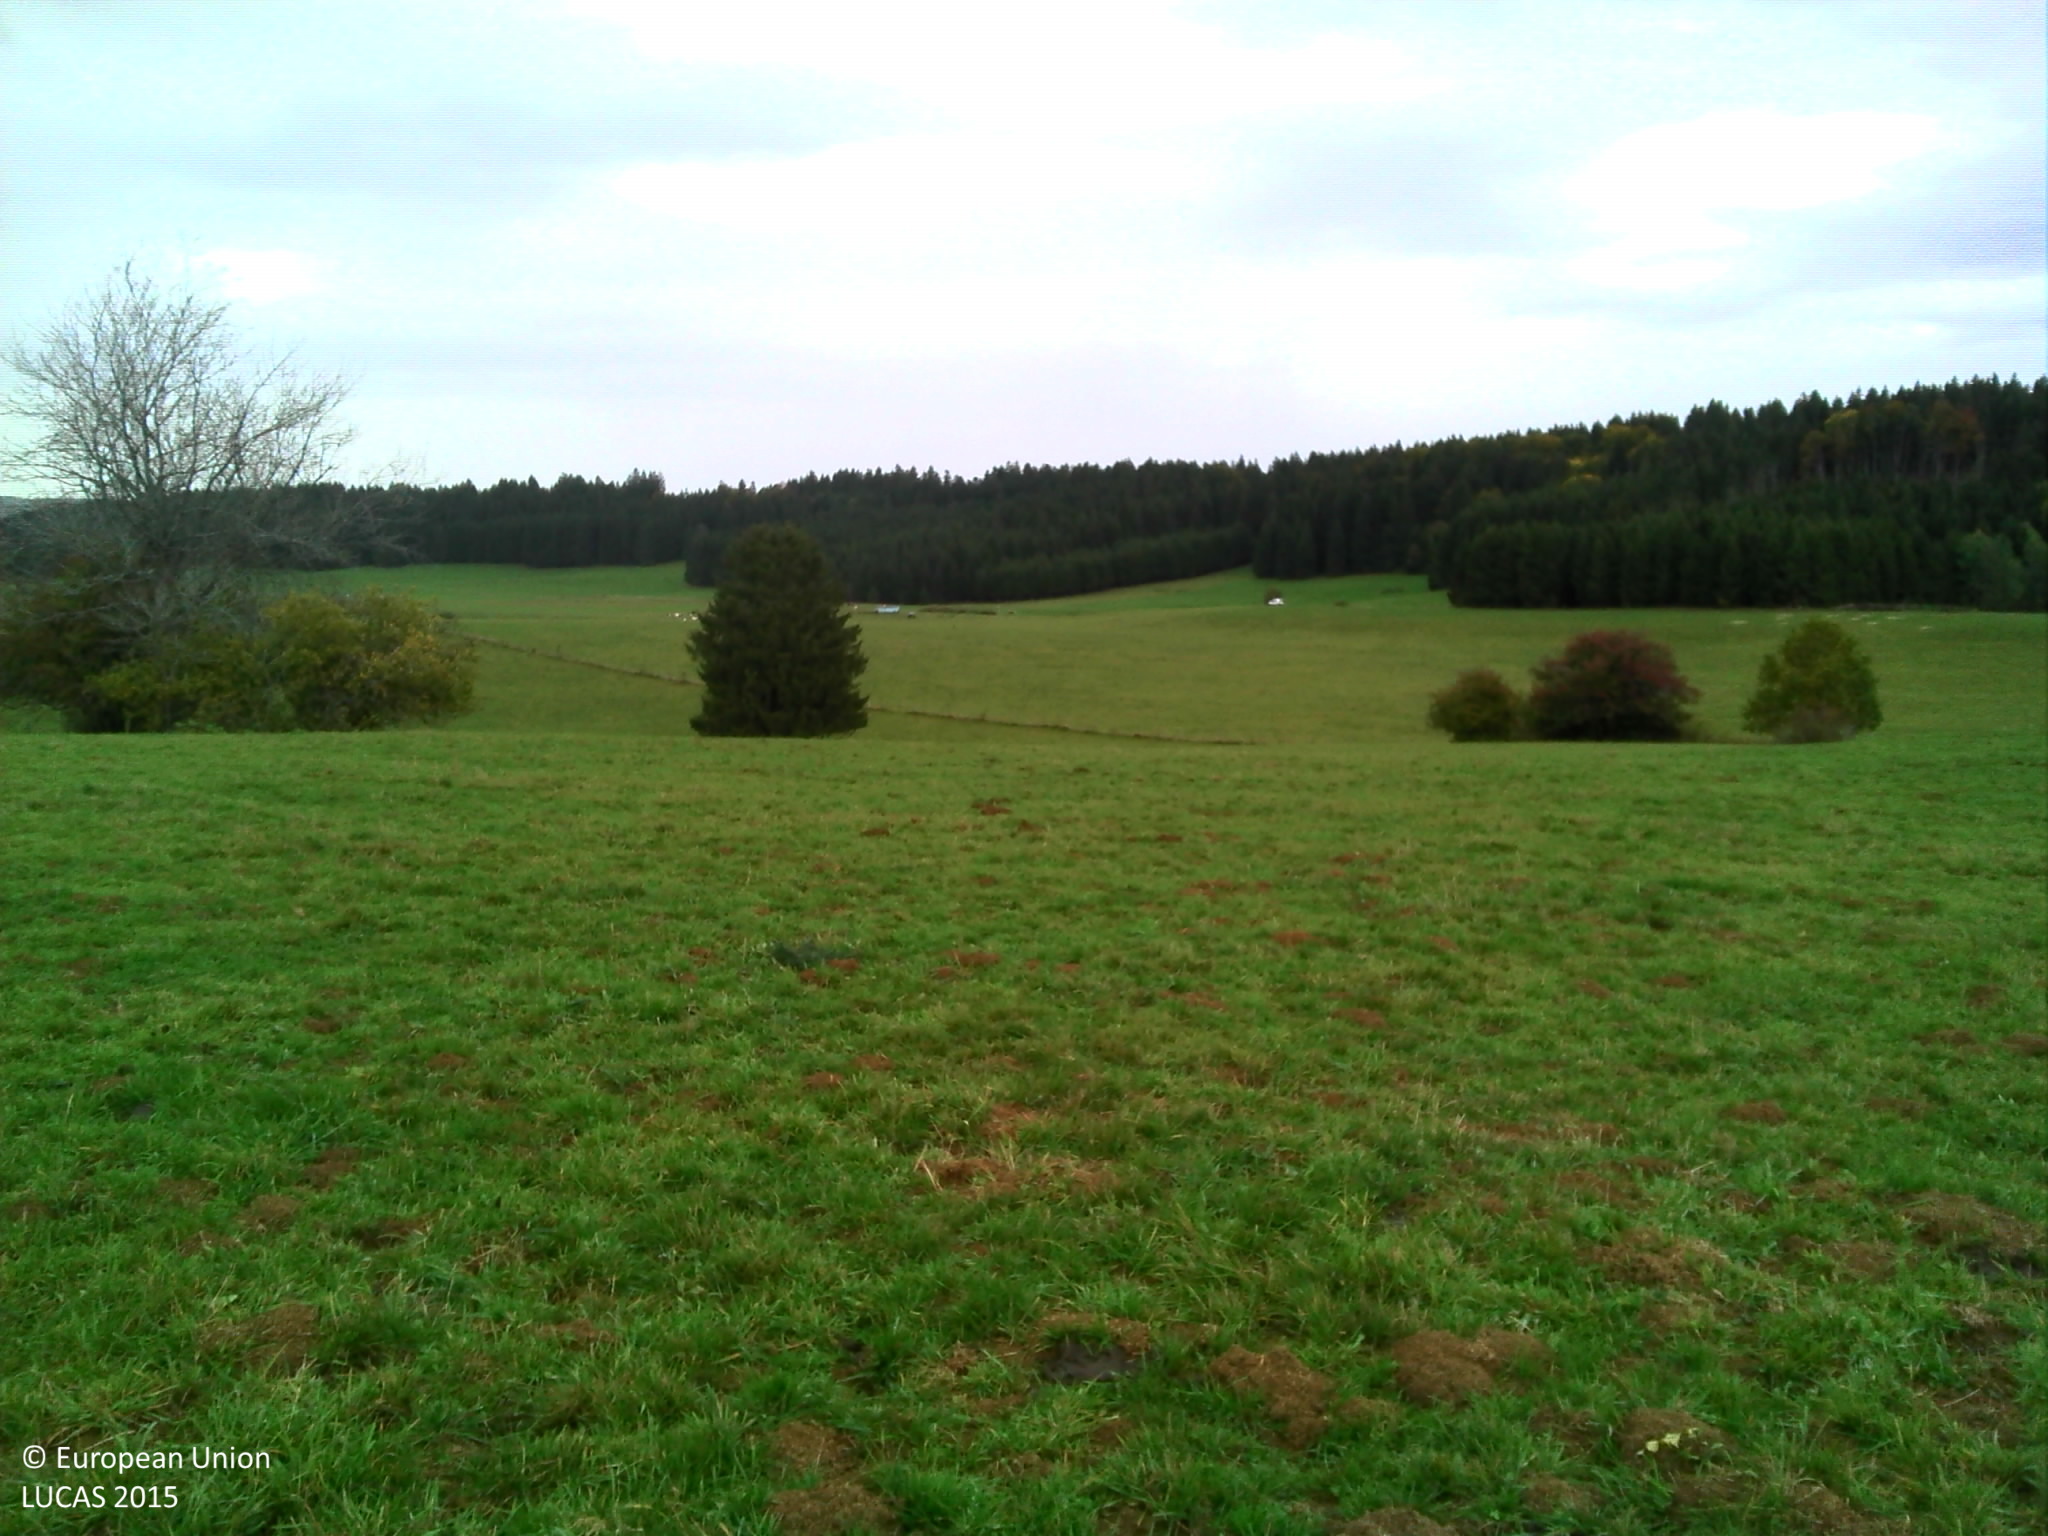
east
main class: Grassland
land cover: Grassland without tree/shrub cover
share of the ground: > 75 %
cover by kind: herbaceous plants 100 %
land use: Agriculture (excluding fallow land and kitchen gardens)
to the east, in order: Grassland without tree/shrub cover; Fences; Grassland without tree/shrub cover
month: October
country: FR
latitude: 46.9546
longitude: 6.3100
